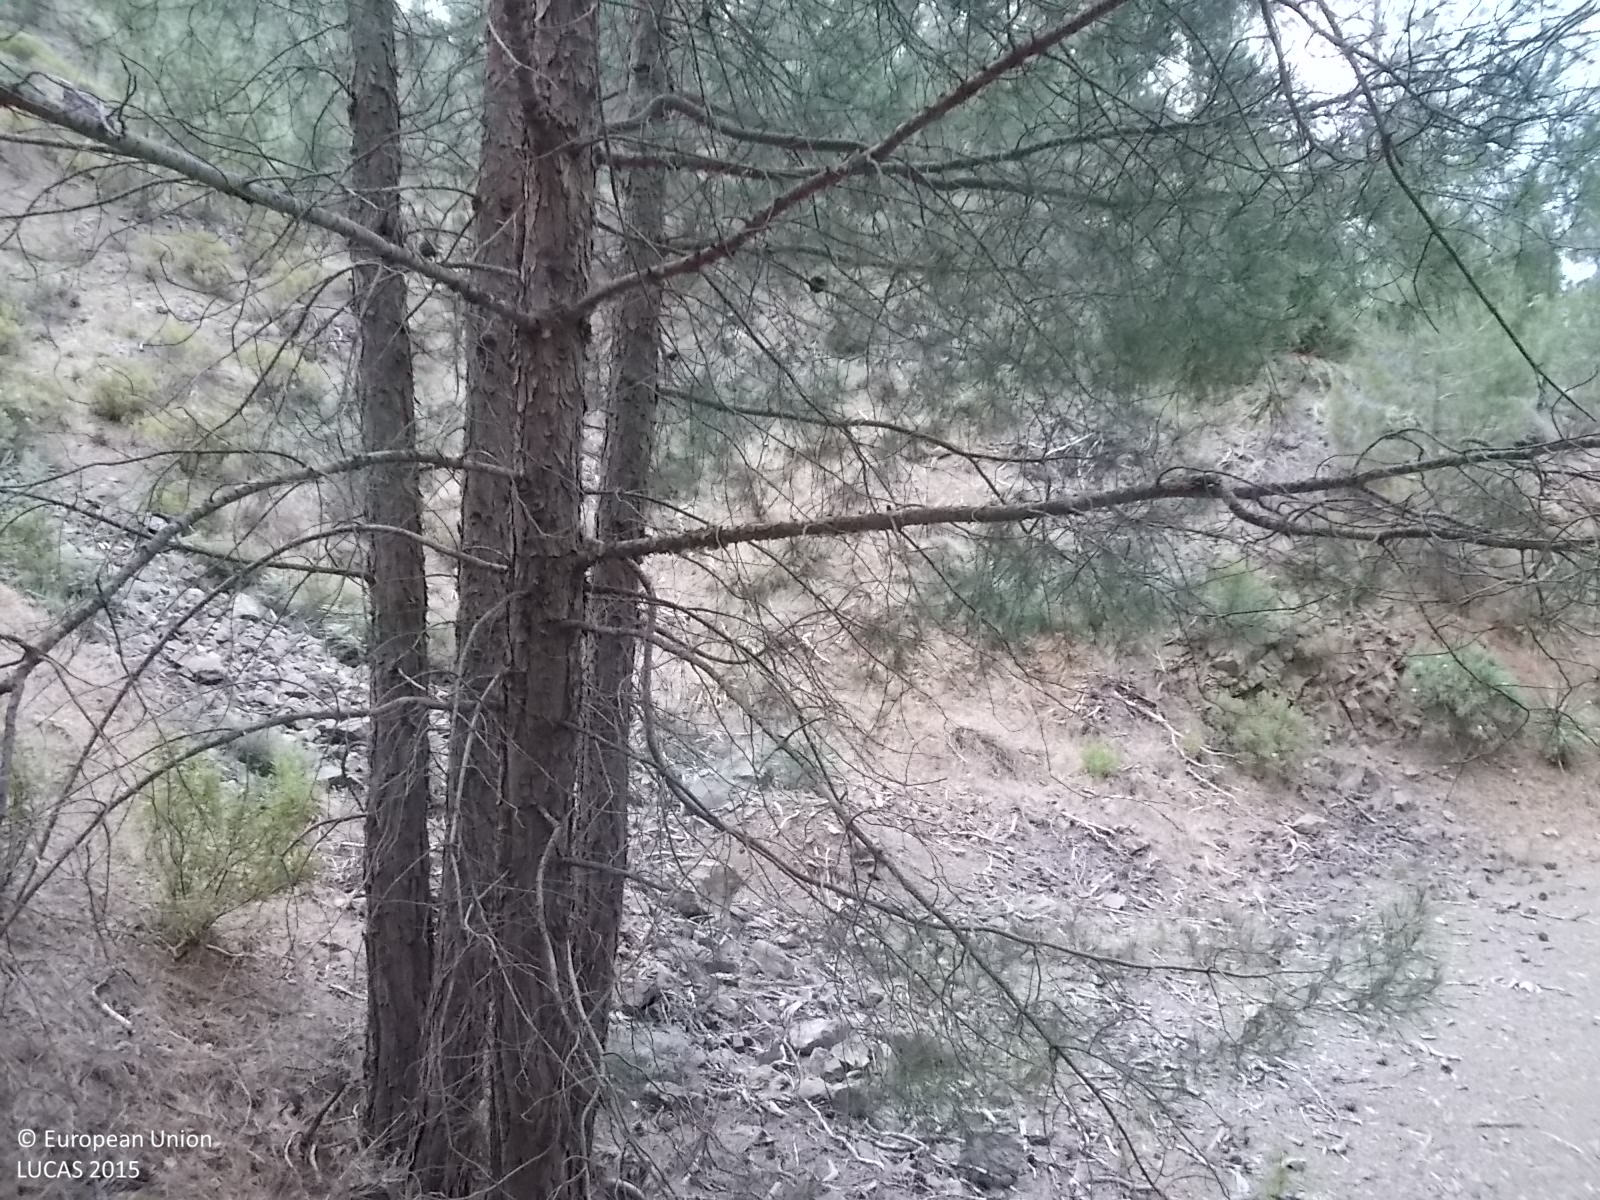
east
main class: Woodland
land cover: Pine dominated coniferous woodland
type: coniferous forest of the mediterranean region
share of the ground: > 75 %
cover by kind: coniferous forest trees 90 %, herbaceous plants 5 %, unconsolidated bare surface 5 %
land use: Forestry
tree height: > 5 m
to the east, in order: Pine dominated coniferous woodland; Paved roads, cycling and walking lanes; Pine dominated coniferous woodland; Paved roads, cycling and walking lanes; Pine dominated coniferous woodland
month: June
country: CY
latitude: 35.0744
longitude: 32.6330
